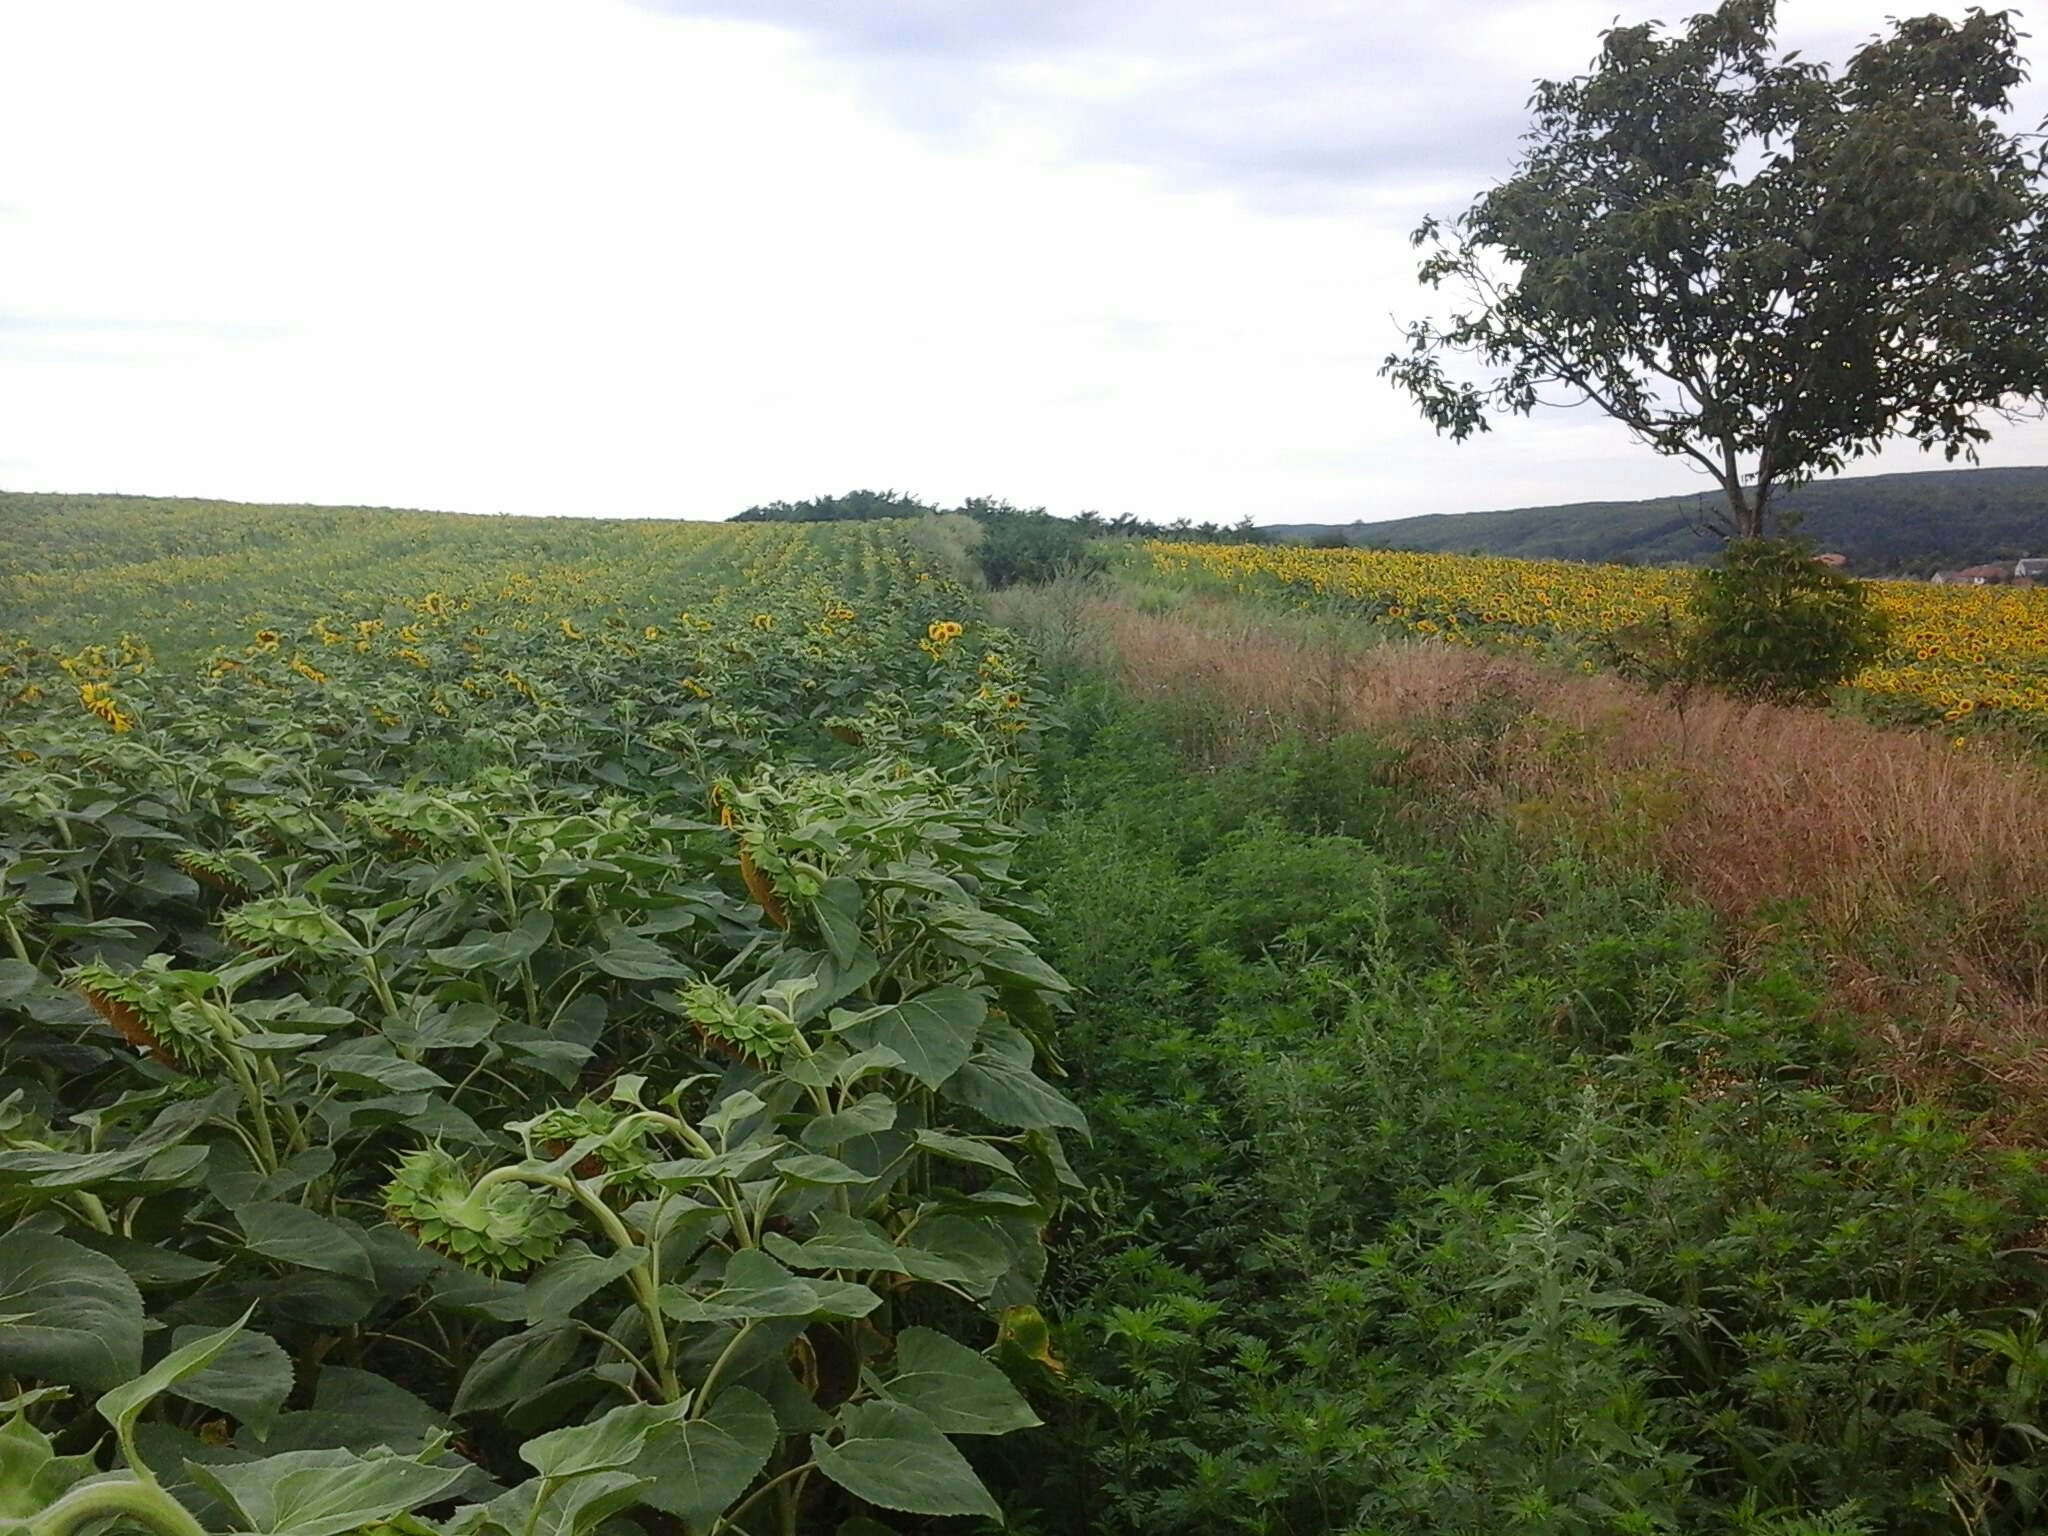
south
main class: Cropland
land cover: Sunflower
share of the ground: > 75 %
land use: Agriculture (excluding fallow land and kitchen gardens)
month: July
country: HU
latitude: 48.4530
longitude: 21.1706
